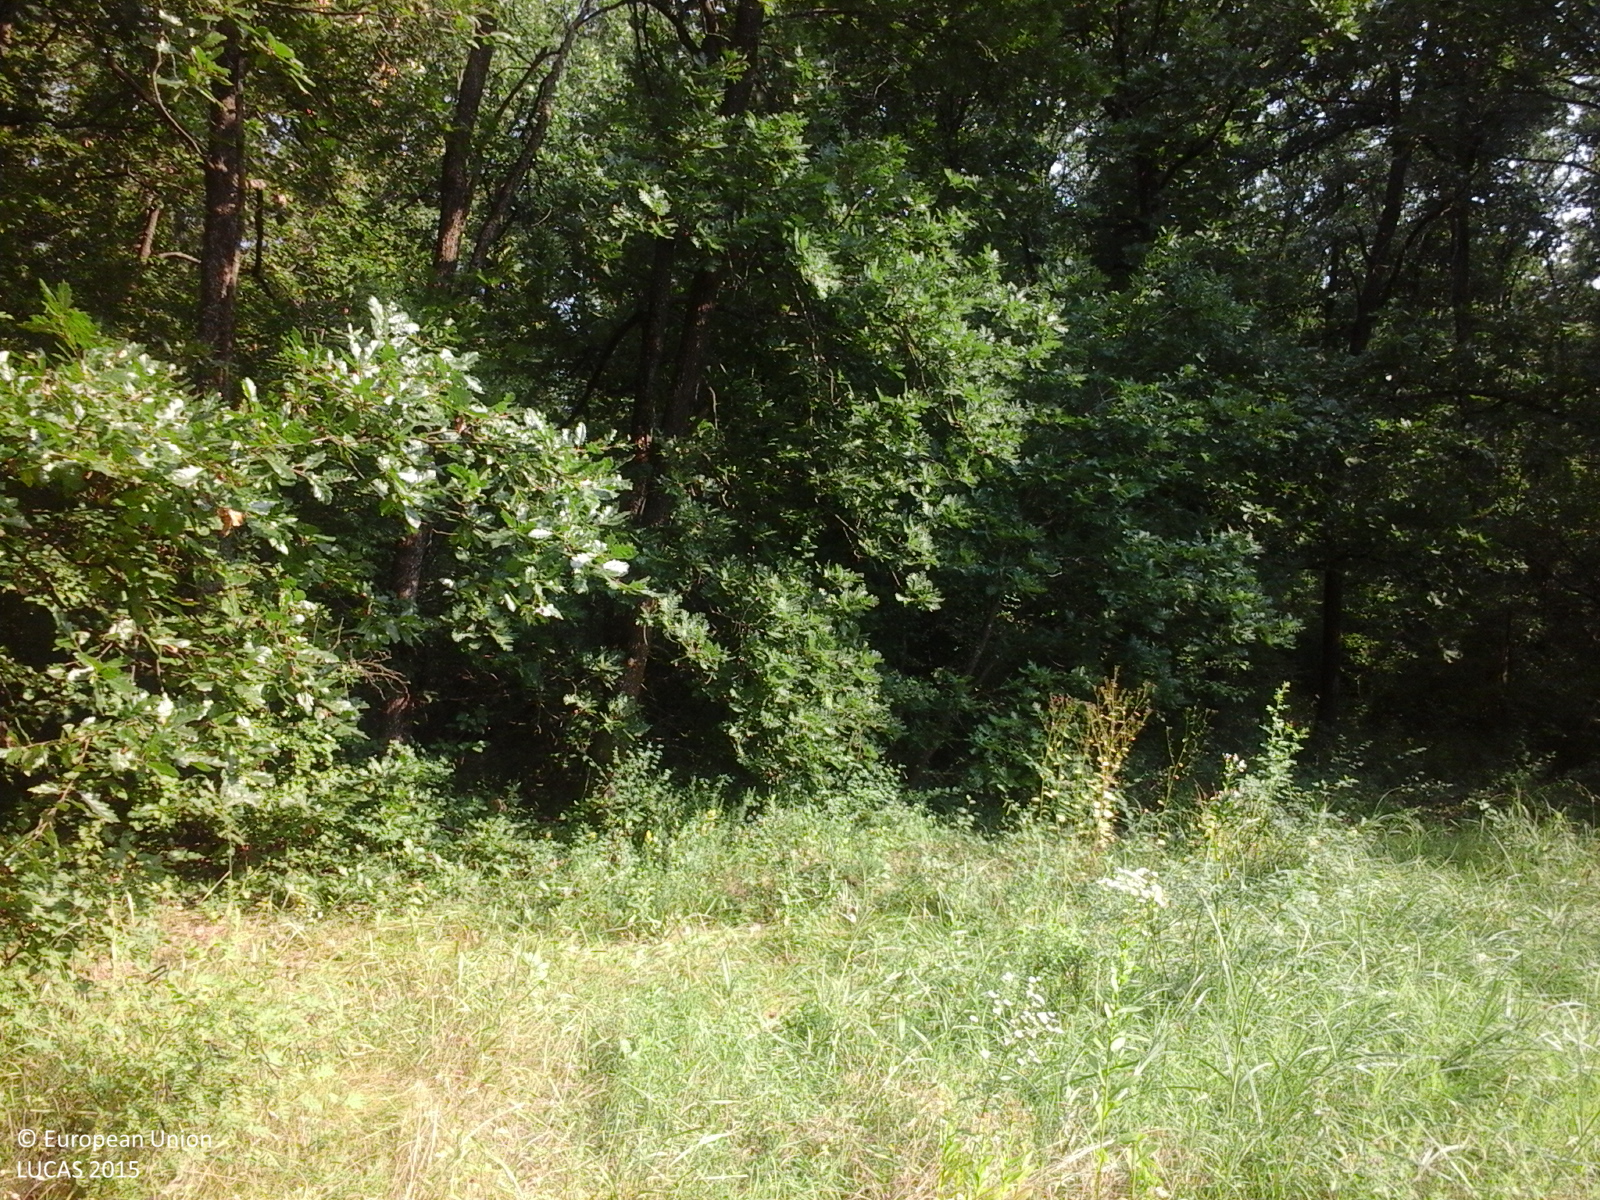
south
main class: Woodland
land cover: Broadleaved woodland
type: acidophilous oak and oak-birch forest
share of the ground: > 75 %
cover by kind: broadleaved forest trees 100 %
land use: Forestry
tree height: > 5 m
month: July
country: RO
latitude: 44.3173
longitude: 25.6016
